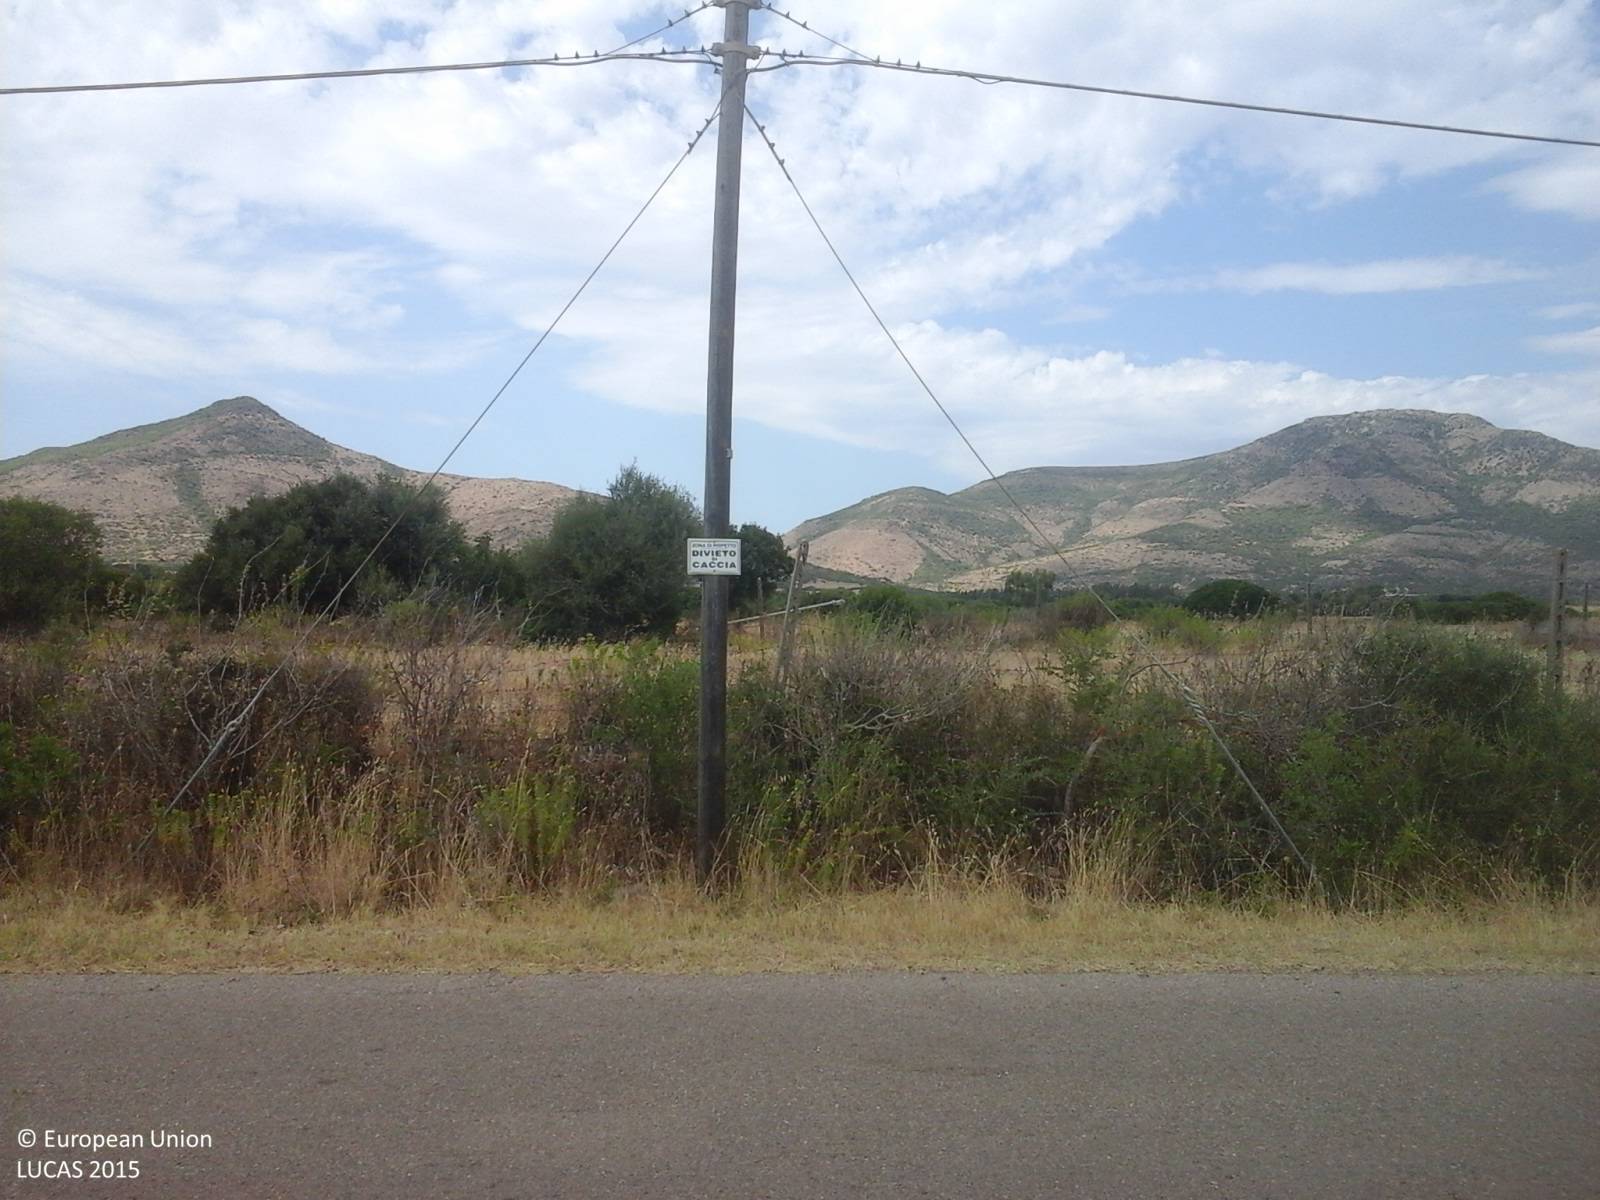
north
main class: Shrubland
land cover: Shrubland without tree cover
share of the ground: > 75 %
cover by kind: shrubs 60 %, herbaceous plants 30 %, unconsolidated bare surface 10 %
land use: Agriculture (excluding fallow land and kitchen gardens)
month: July
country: IT
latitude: 39.1155
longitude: 8.5633
